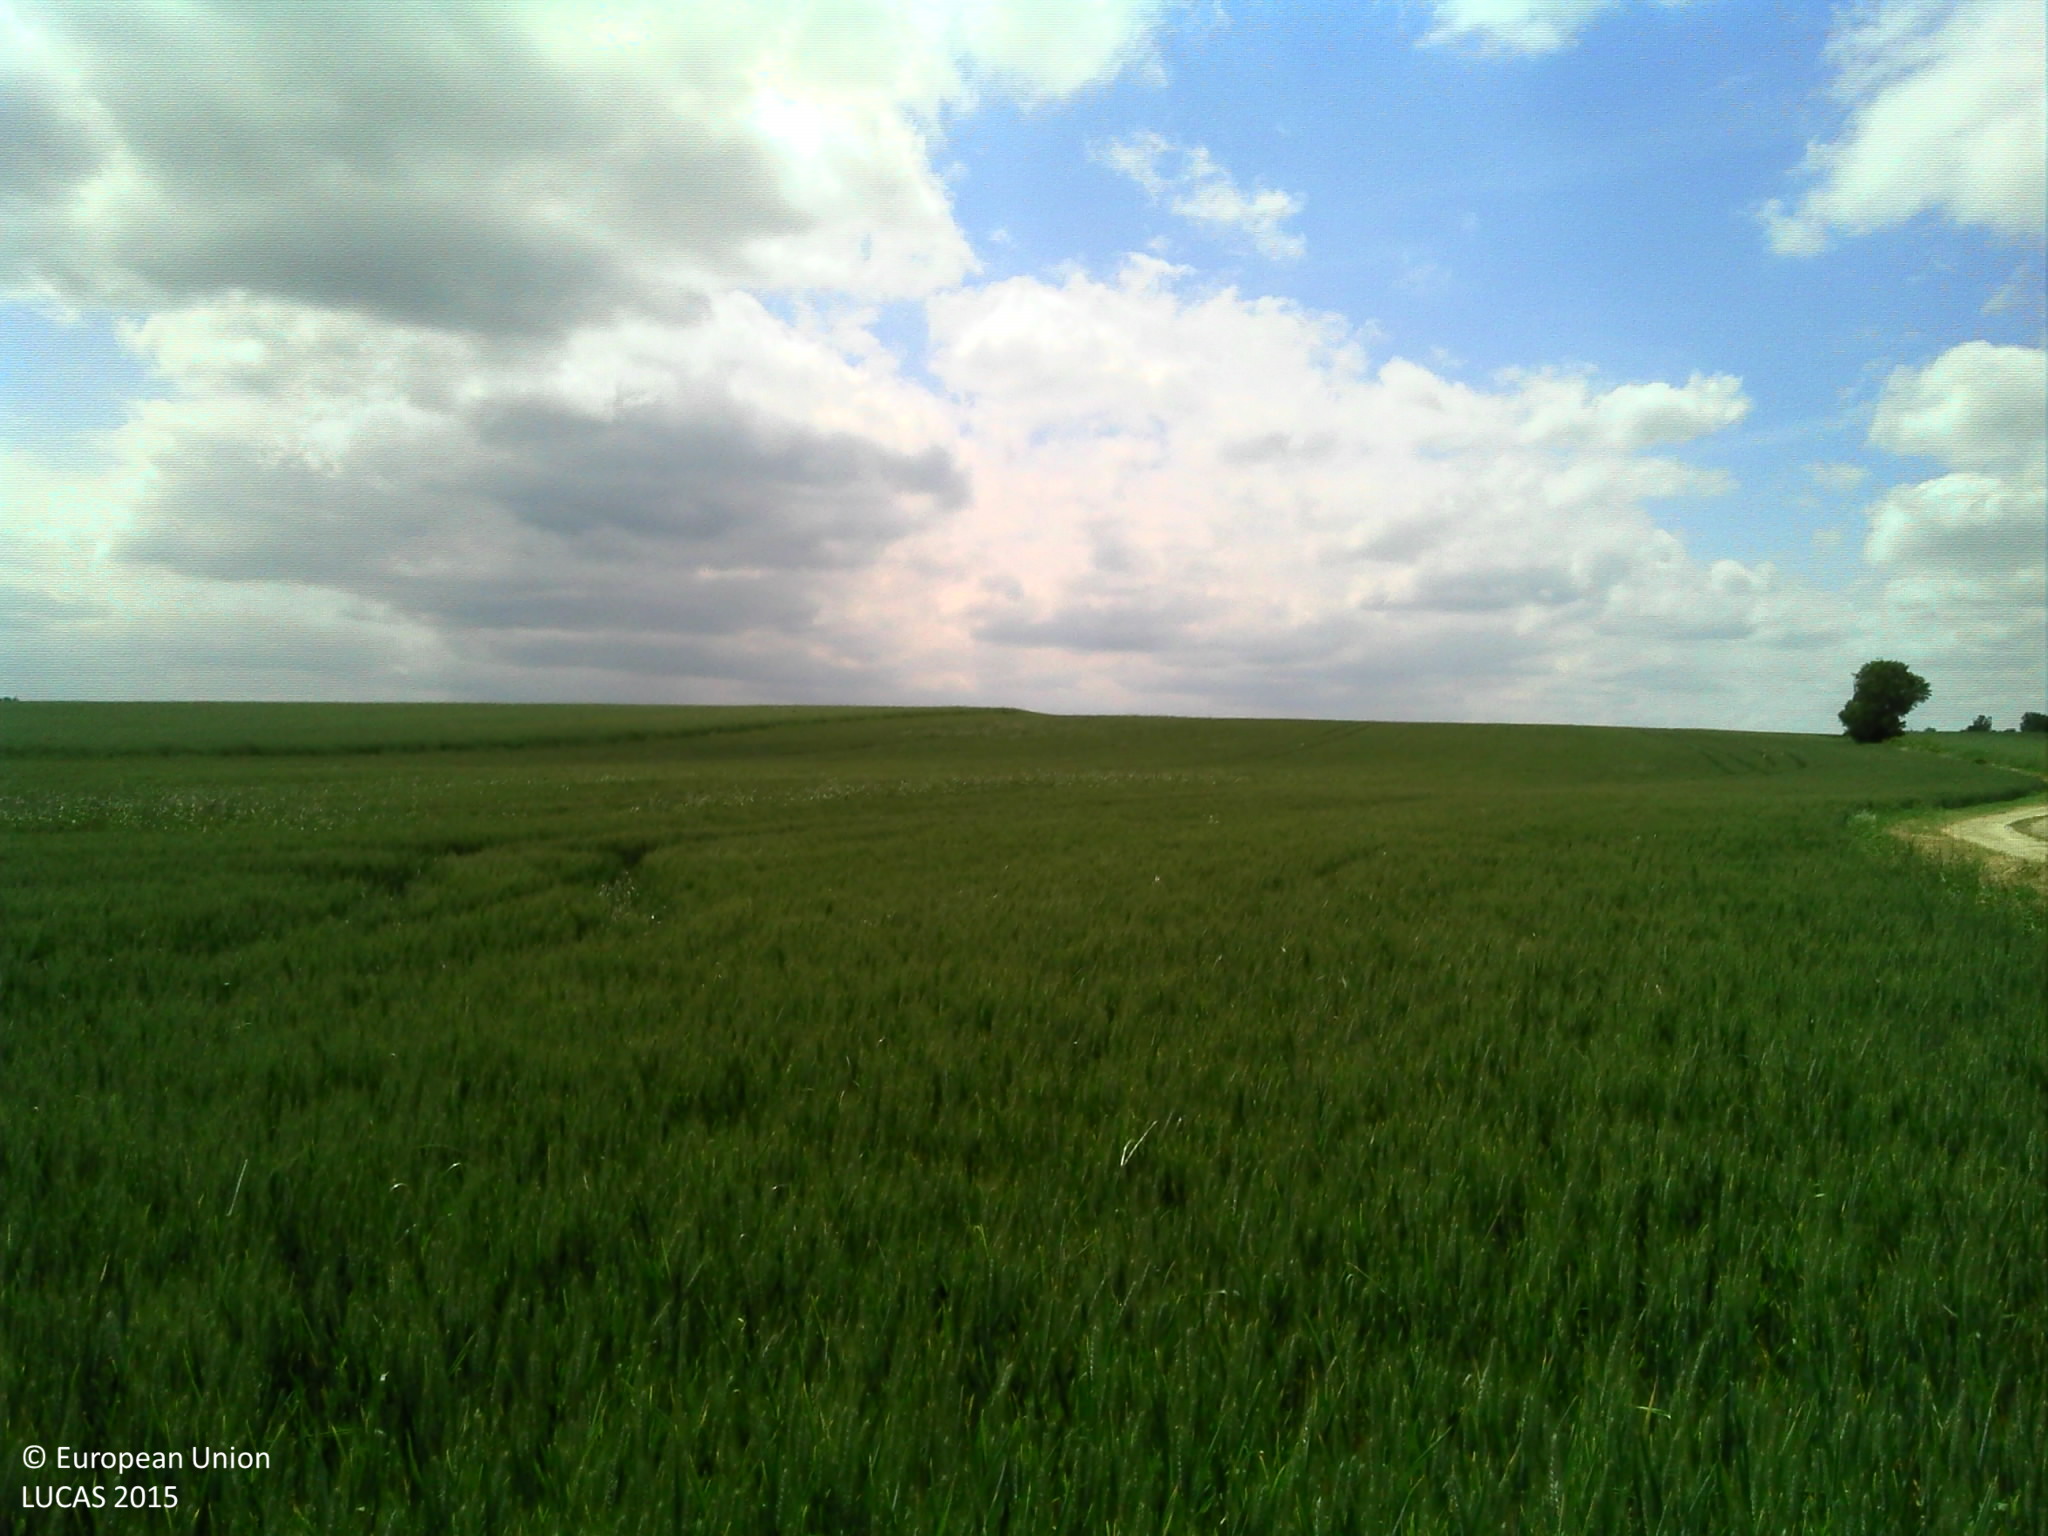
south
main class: Cropland
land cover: Common wheat
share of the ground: > 75 %
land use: Agriculture (excluding fallow land and kitchen gardens)
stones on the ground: < 10 %
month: May
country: FR
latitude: 47.4201
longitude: 5.2951
